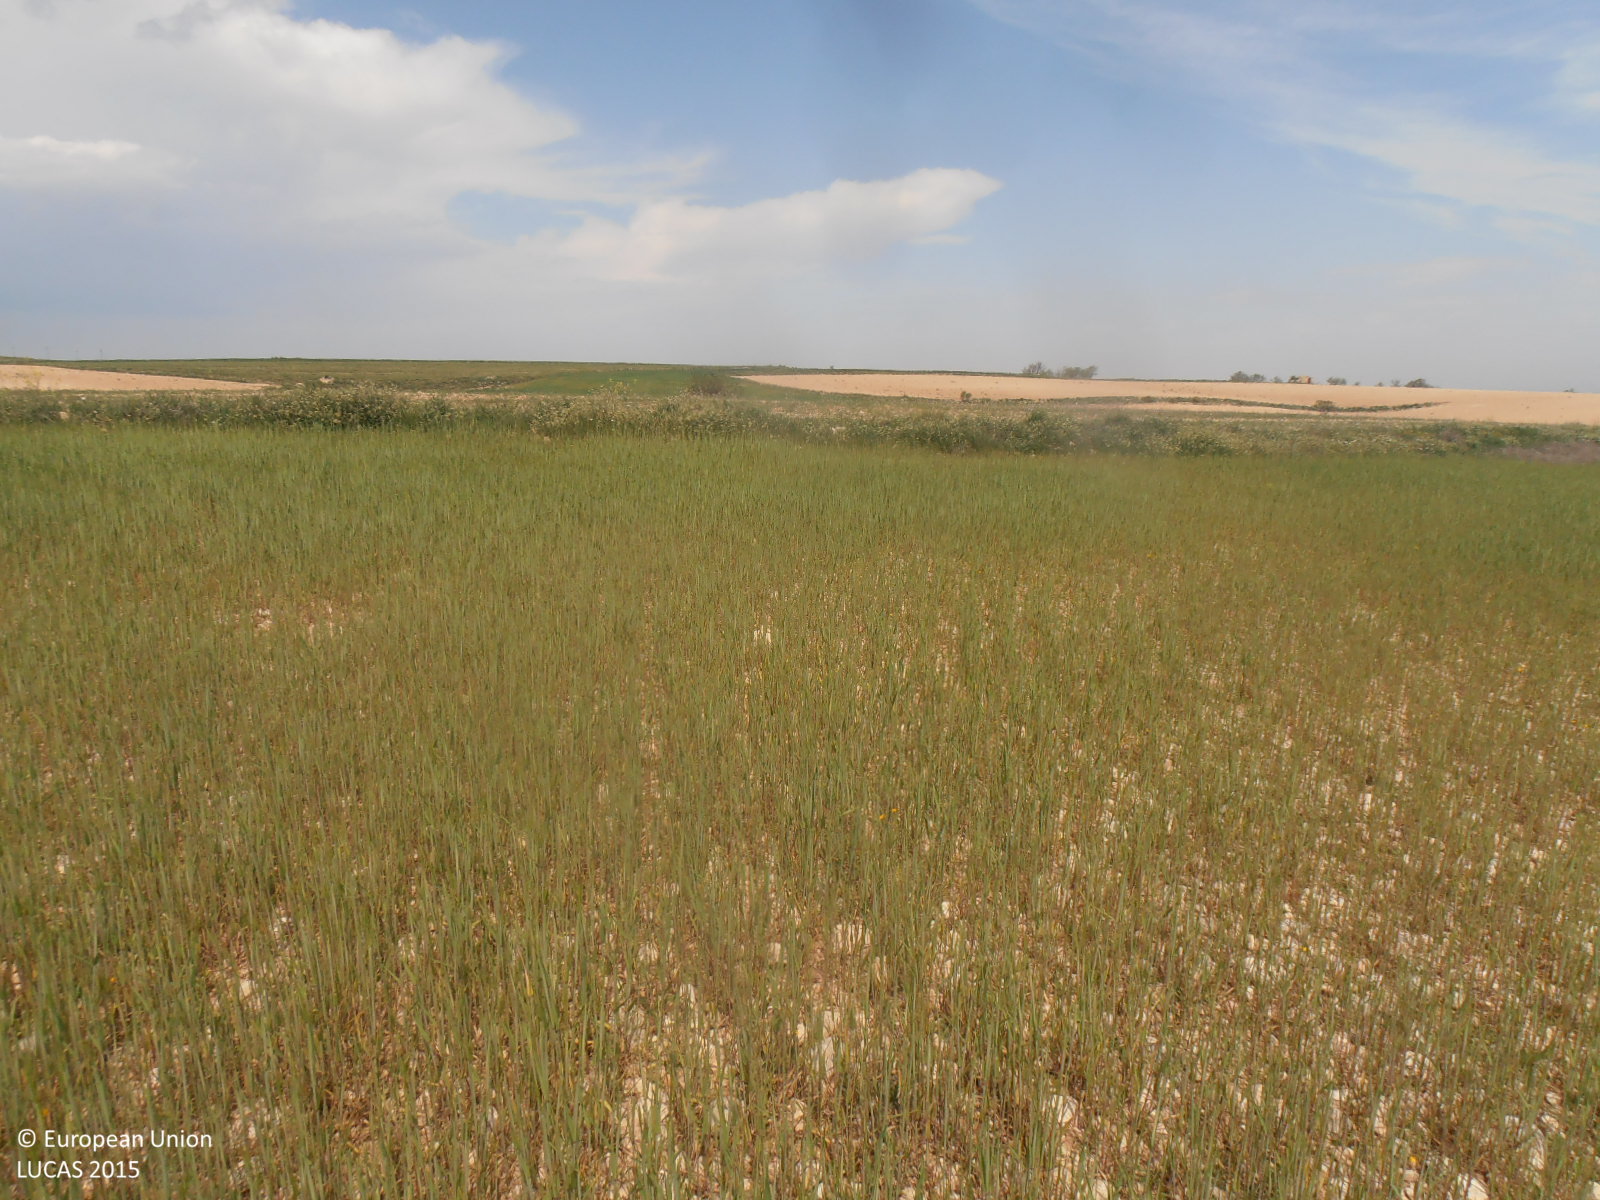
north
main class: Cropland
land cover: Barley
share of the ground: > 75 %
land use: Agriculture (excluding fallow land and kitchen gardens)
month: April
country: ES
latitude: 41.2278
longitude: -0.7176
